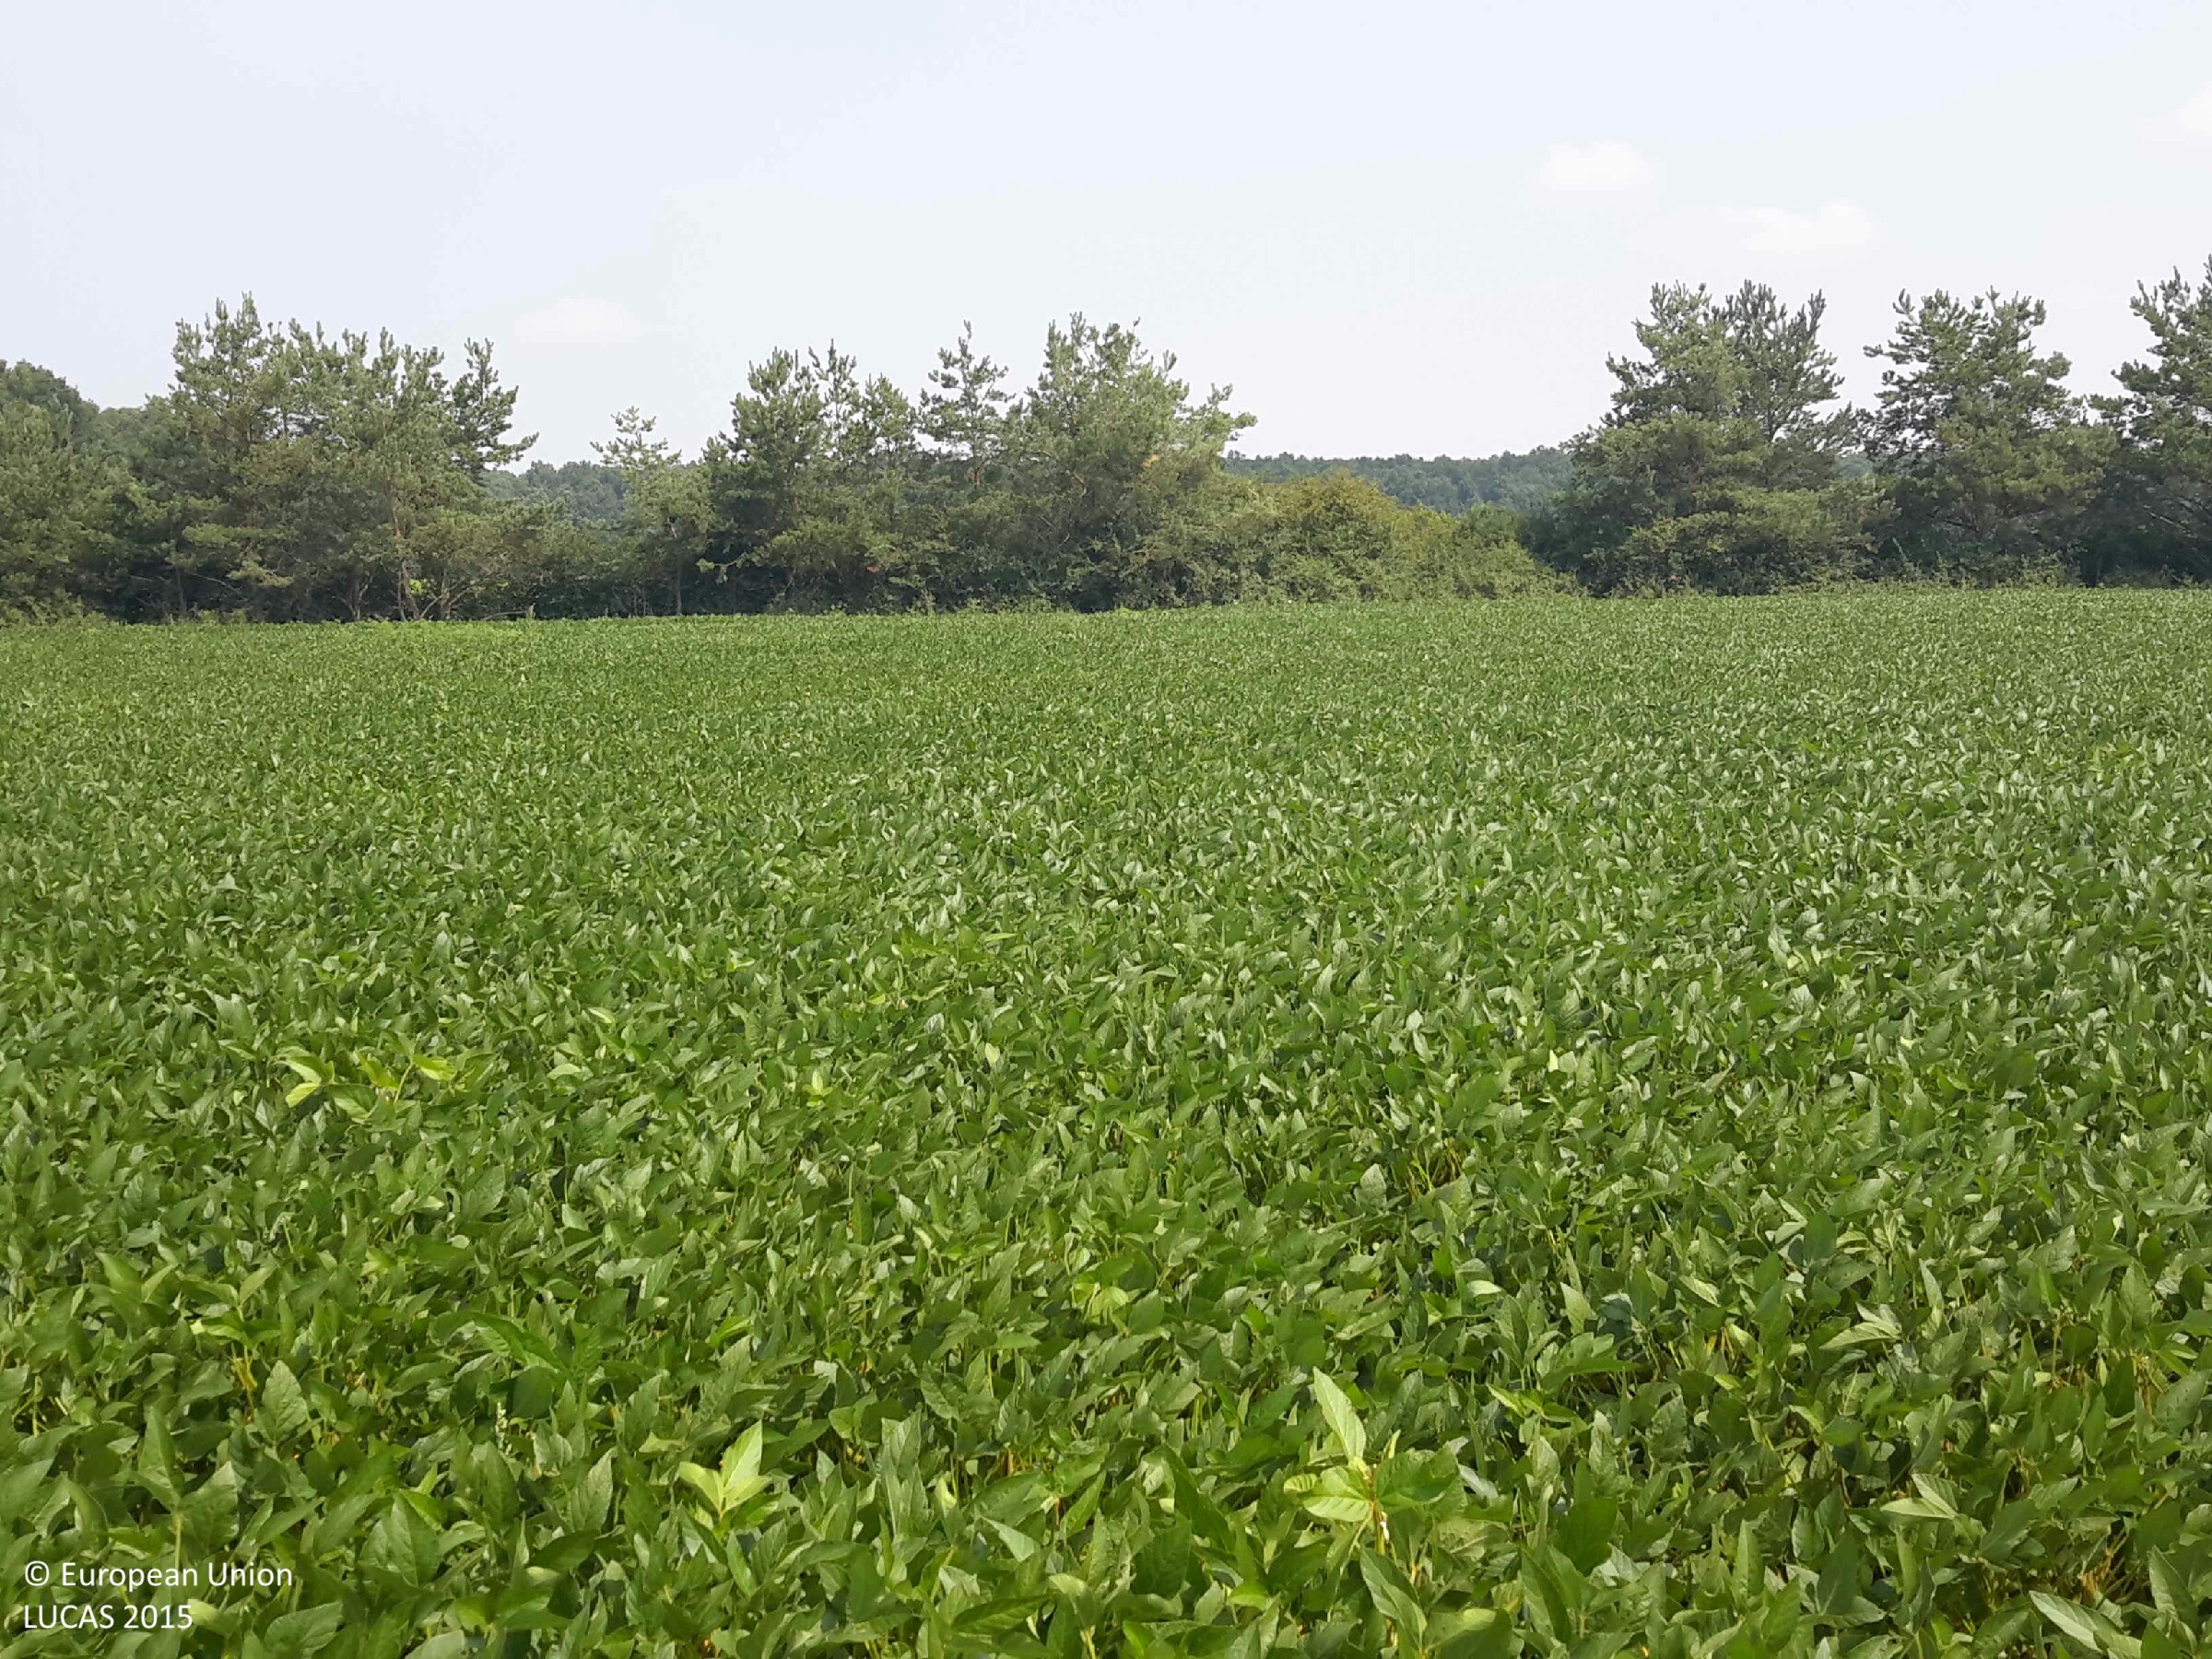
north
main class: Cropland
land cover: Soya
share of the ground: > 75 %
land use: Agriculture (excluding fallow land and kitchen gardens)
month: August
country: HU
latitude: 47.0734
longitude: 16.5215
